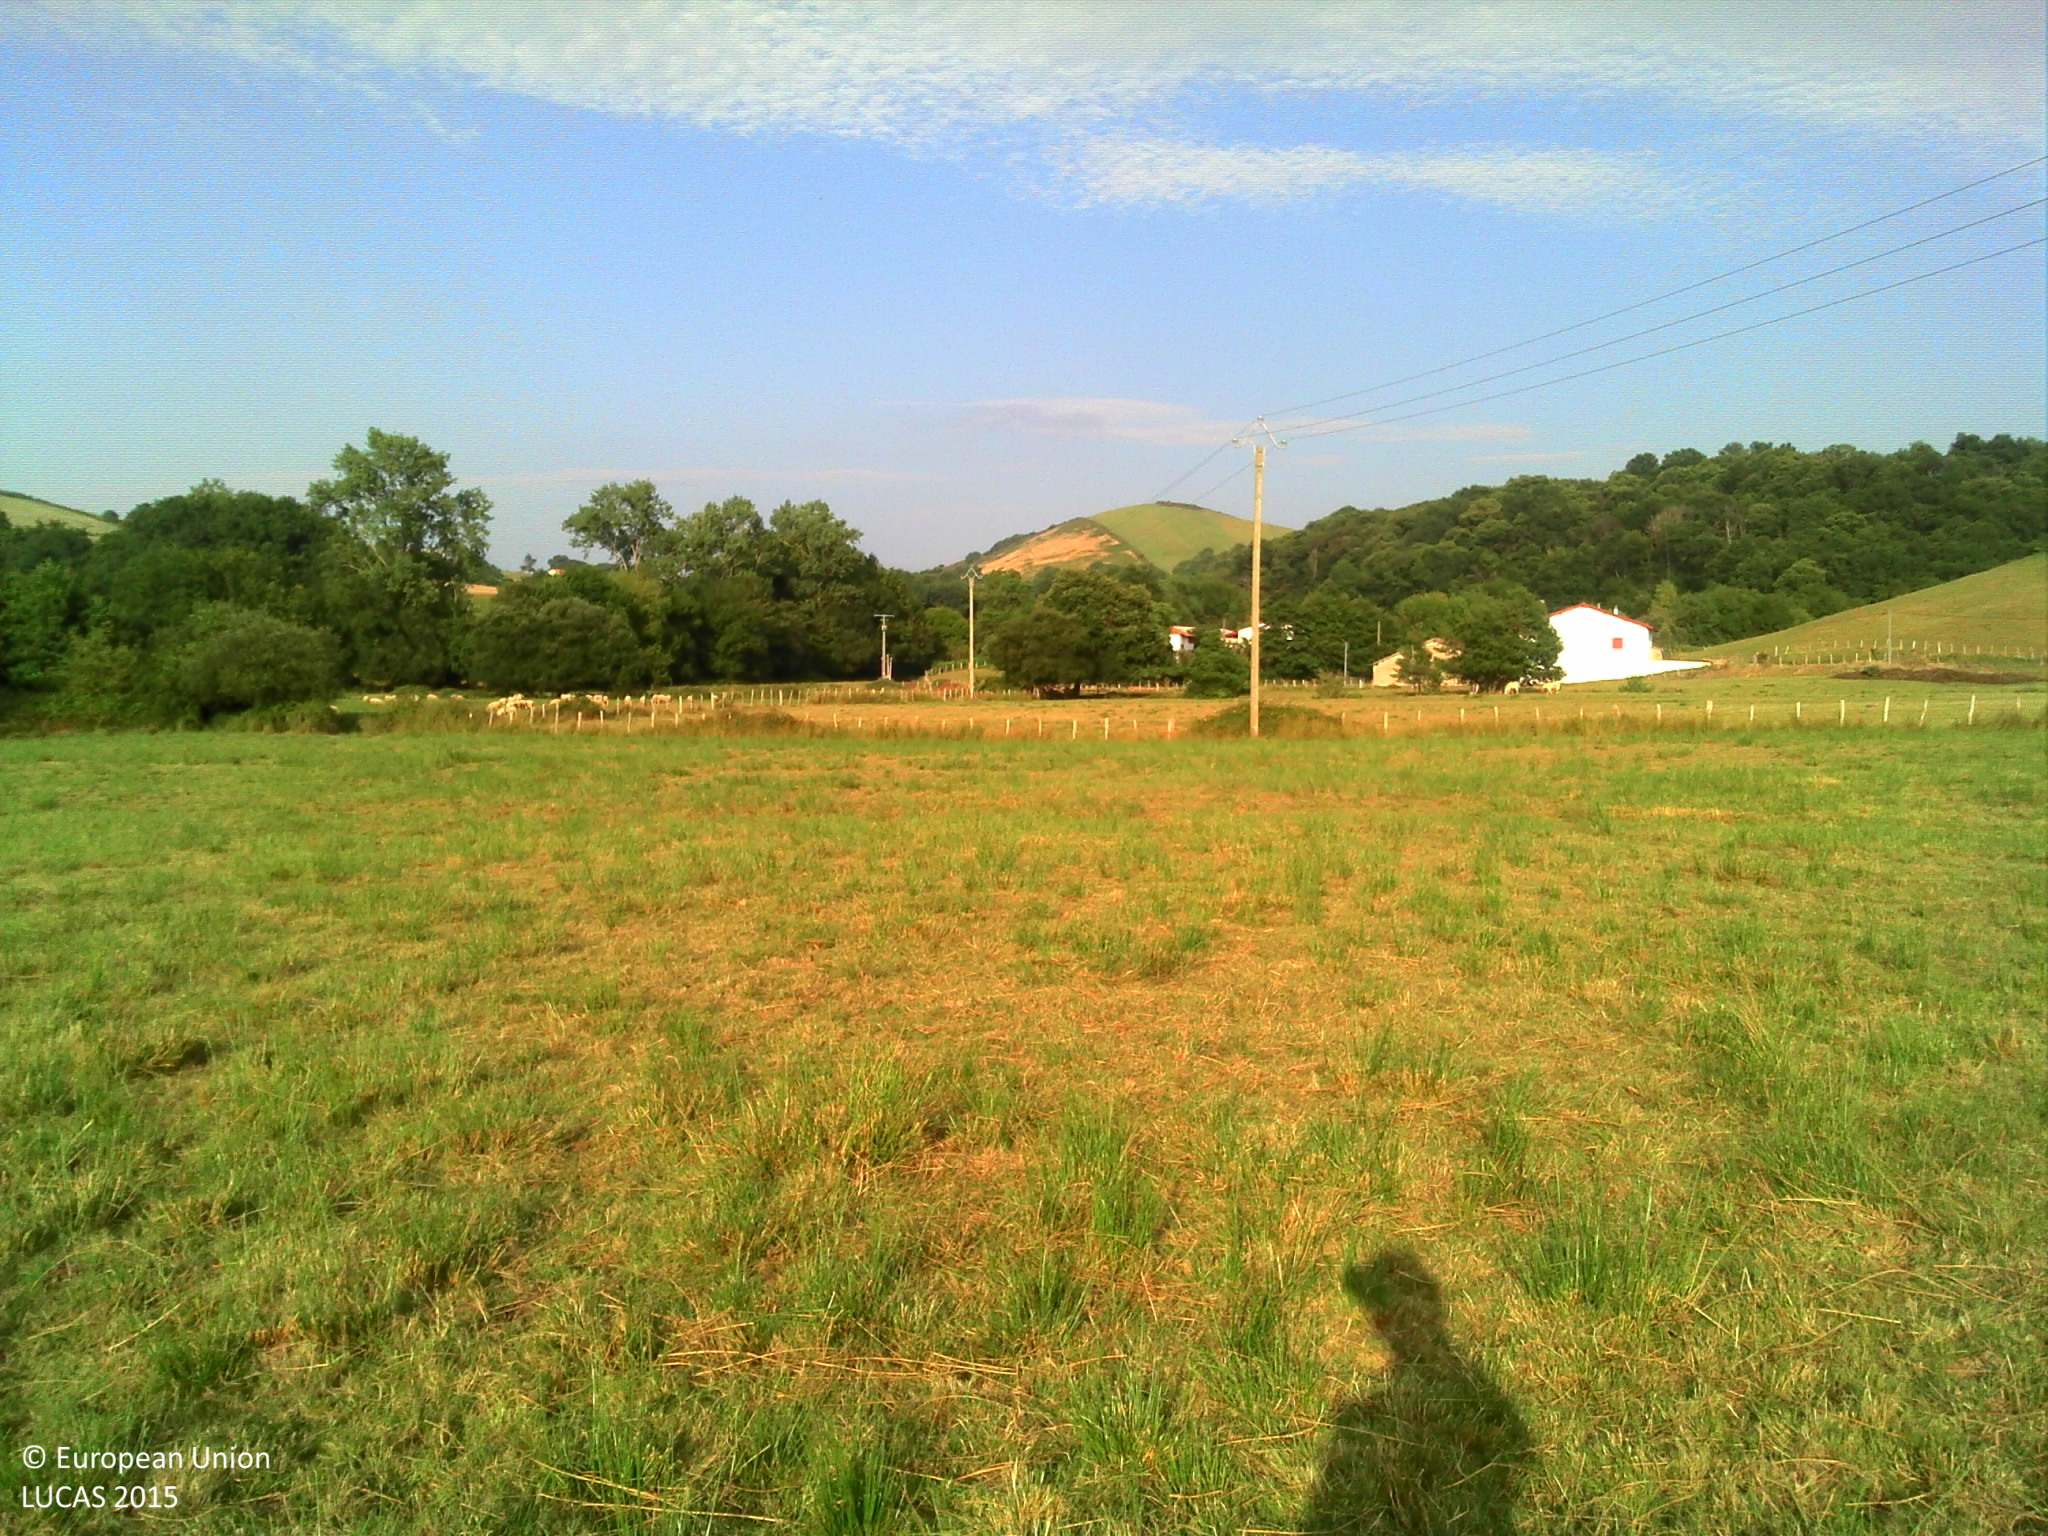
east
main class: Grassland
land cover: Grassland without tree/shrub cover
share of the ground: > 75 %
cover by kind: herbaceous plants 100 %
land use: Agriculture (excluding fallow land and kitchen gardens)
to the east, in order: Grassland without tree/shrub cover; Fences; Grassland without tree/shrub cover; Electric lines; Grassland without tree/shrub cover; Rivers and streams; Single bushes/trees; Grassland without tree/shrub cover; Fences; Electric lines; Ditches and canals; Paved roads, cycling and walking lanes; Grass margins; Fences; Grassland without tree/shrub cover
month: August
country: FR
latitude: 43.3184
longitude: -1.2478
